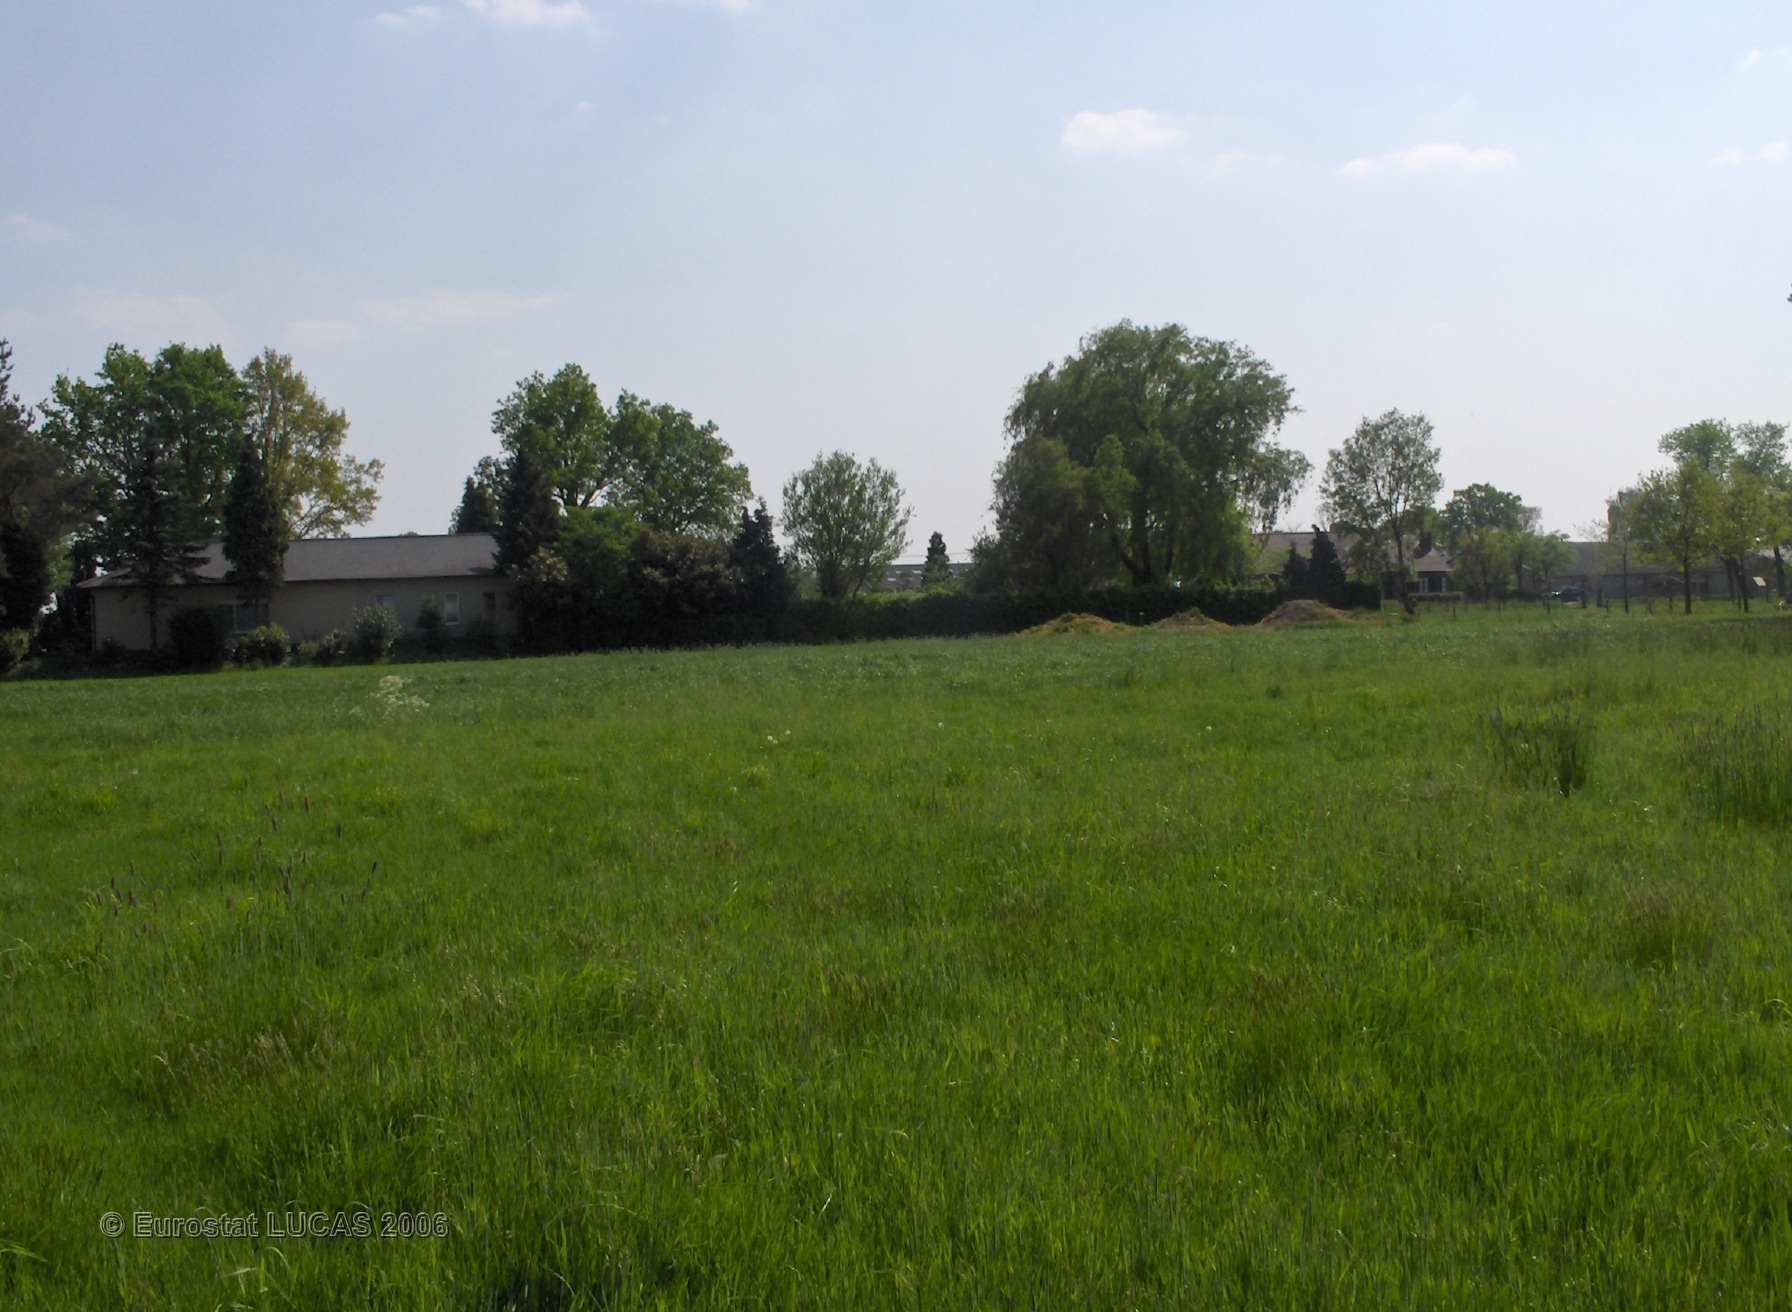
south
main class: Grassland
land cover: Grassland without tree/shrub cover
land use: Agriculture (excluding fallow land and kitchen gardens)
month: May
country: BE
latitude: 51.2515
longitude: 5.1404
